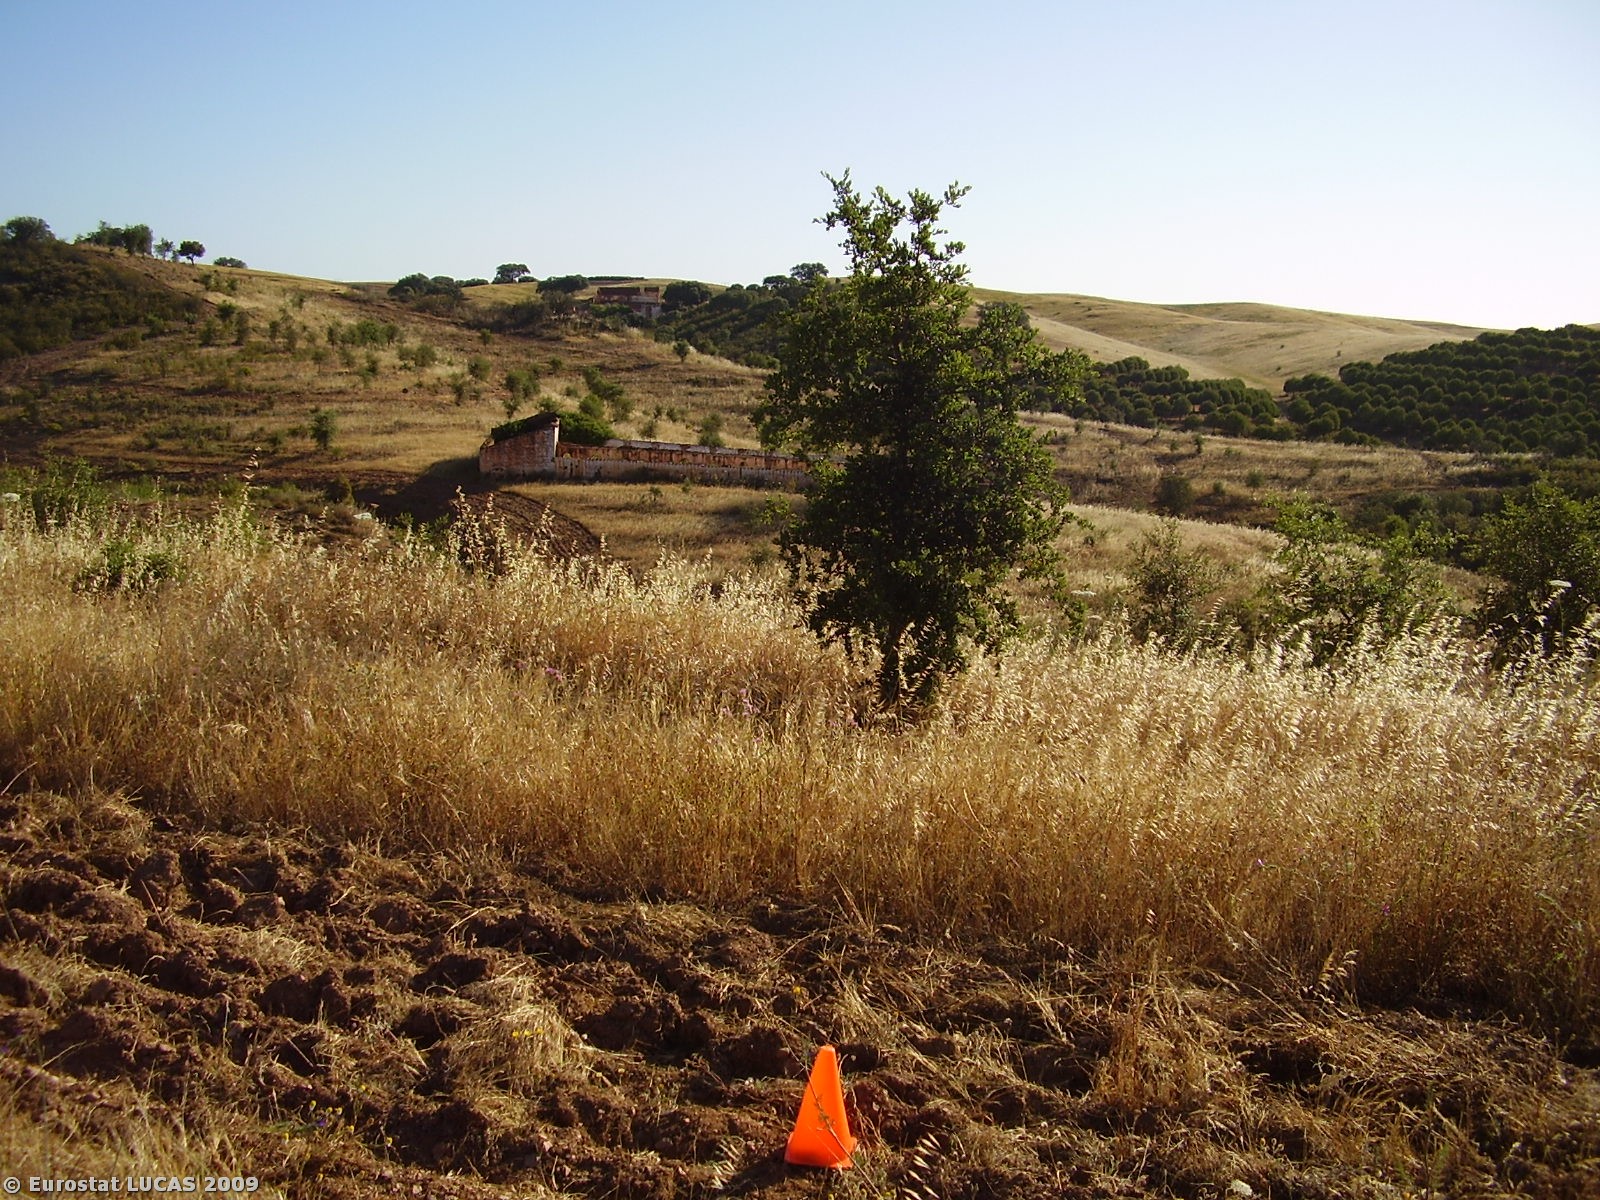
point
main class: Woodland
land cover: Broadleaved woodland
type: broadleaved evergreen forest
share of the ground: 10 - 25 %
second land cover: Spontaneously vegetated surfaces
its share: > 75 %
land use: Forestry
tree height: > 5 m
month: May
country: PT
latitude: 37.7806
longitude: -7.7674
